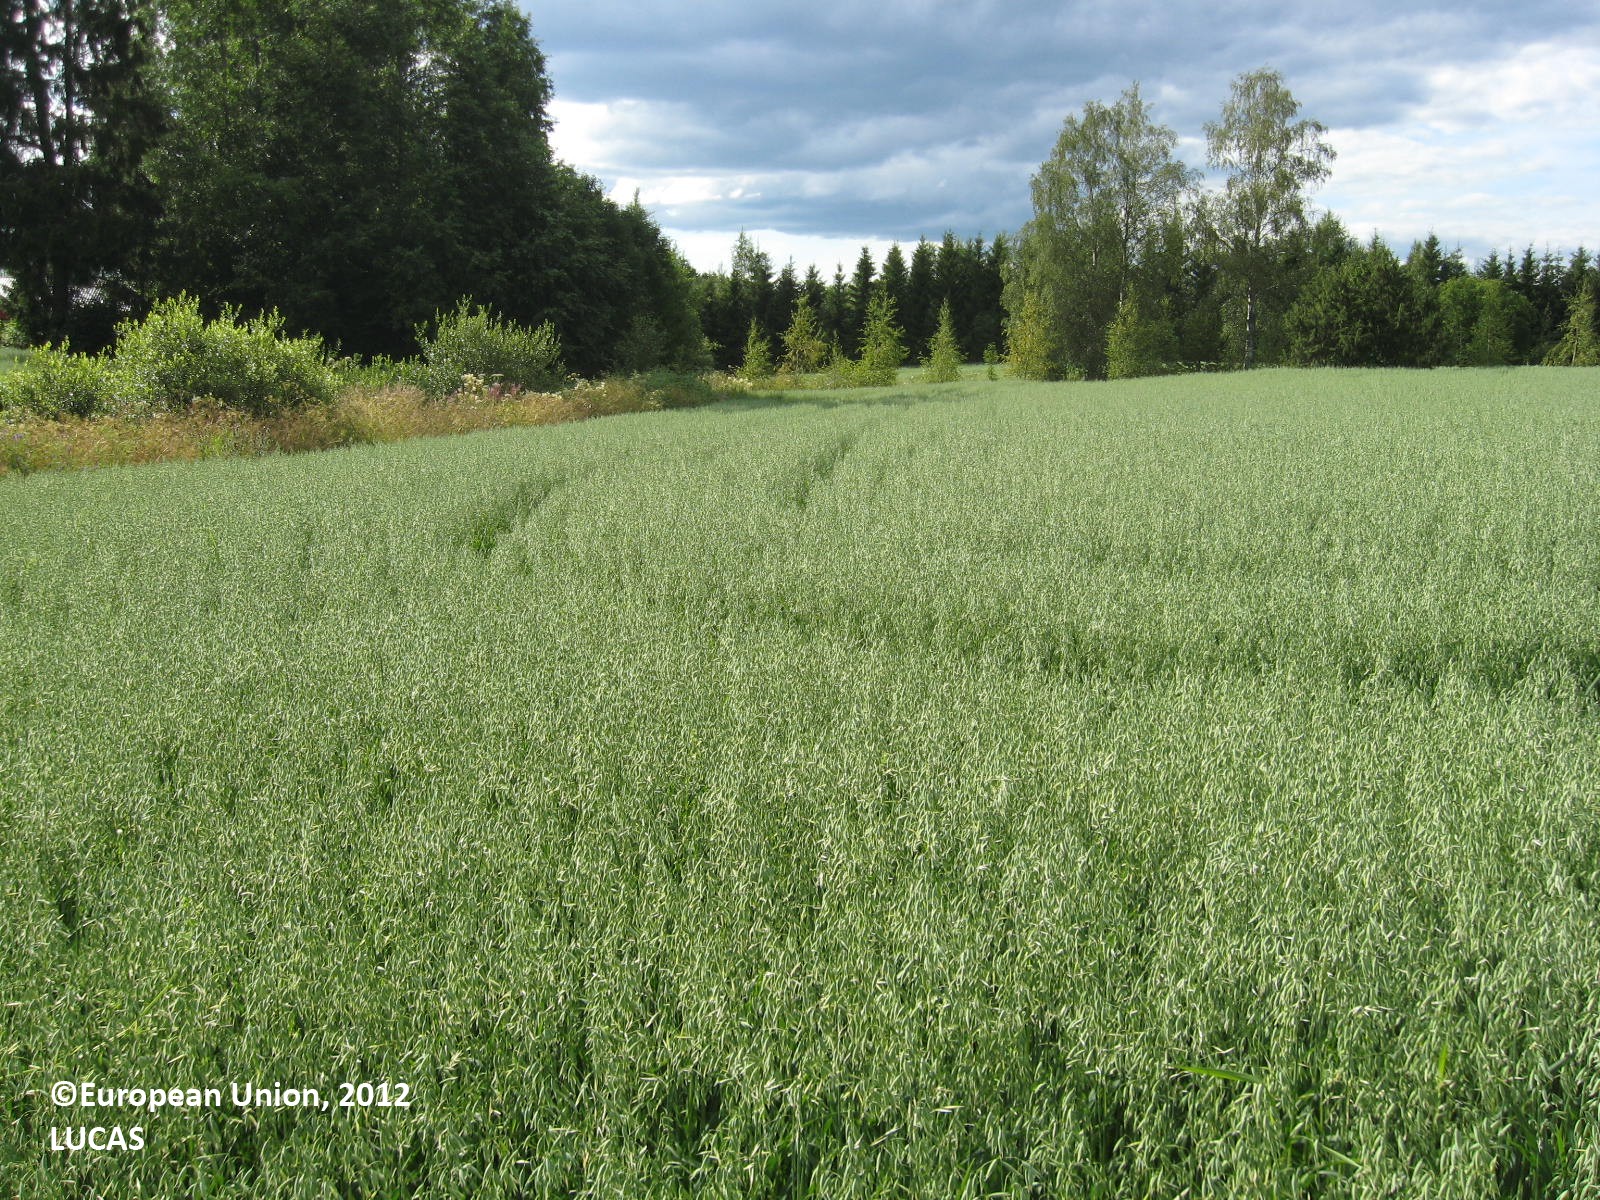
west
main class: Cropland
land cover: Oats
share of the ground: > 75 %
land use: Agriculture (excluding fallow land and kitchen gardens)
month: July
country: FI
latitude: 61.9997
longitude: 22.2572
